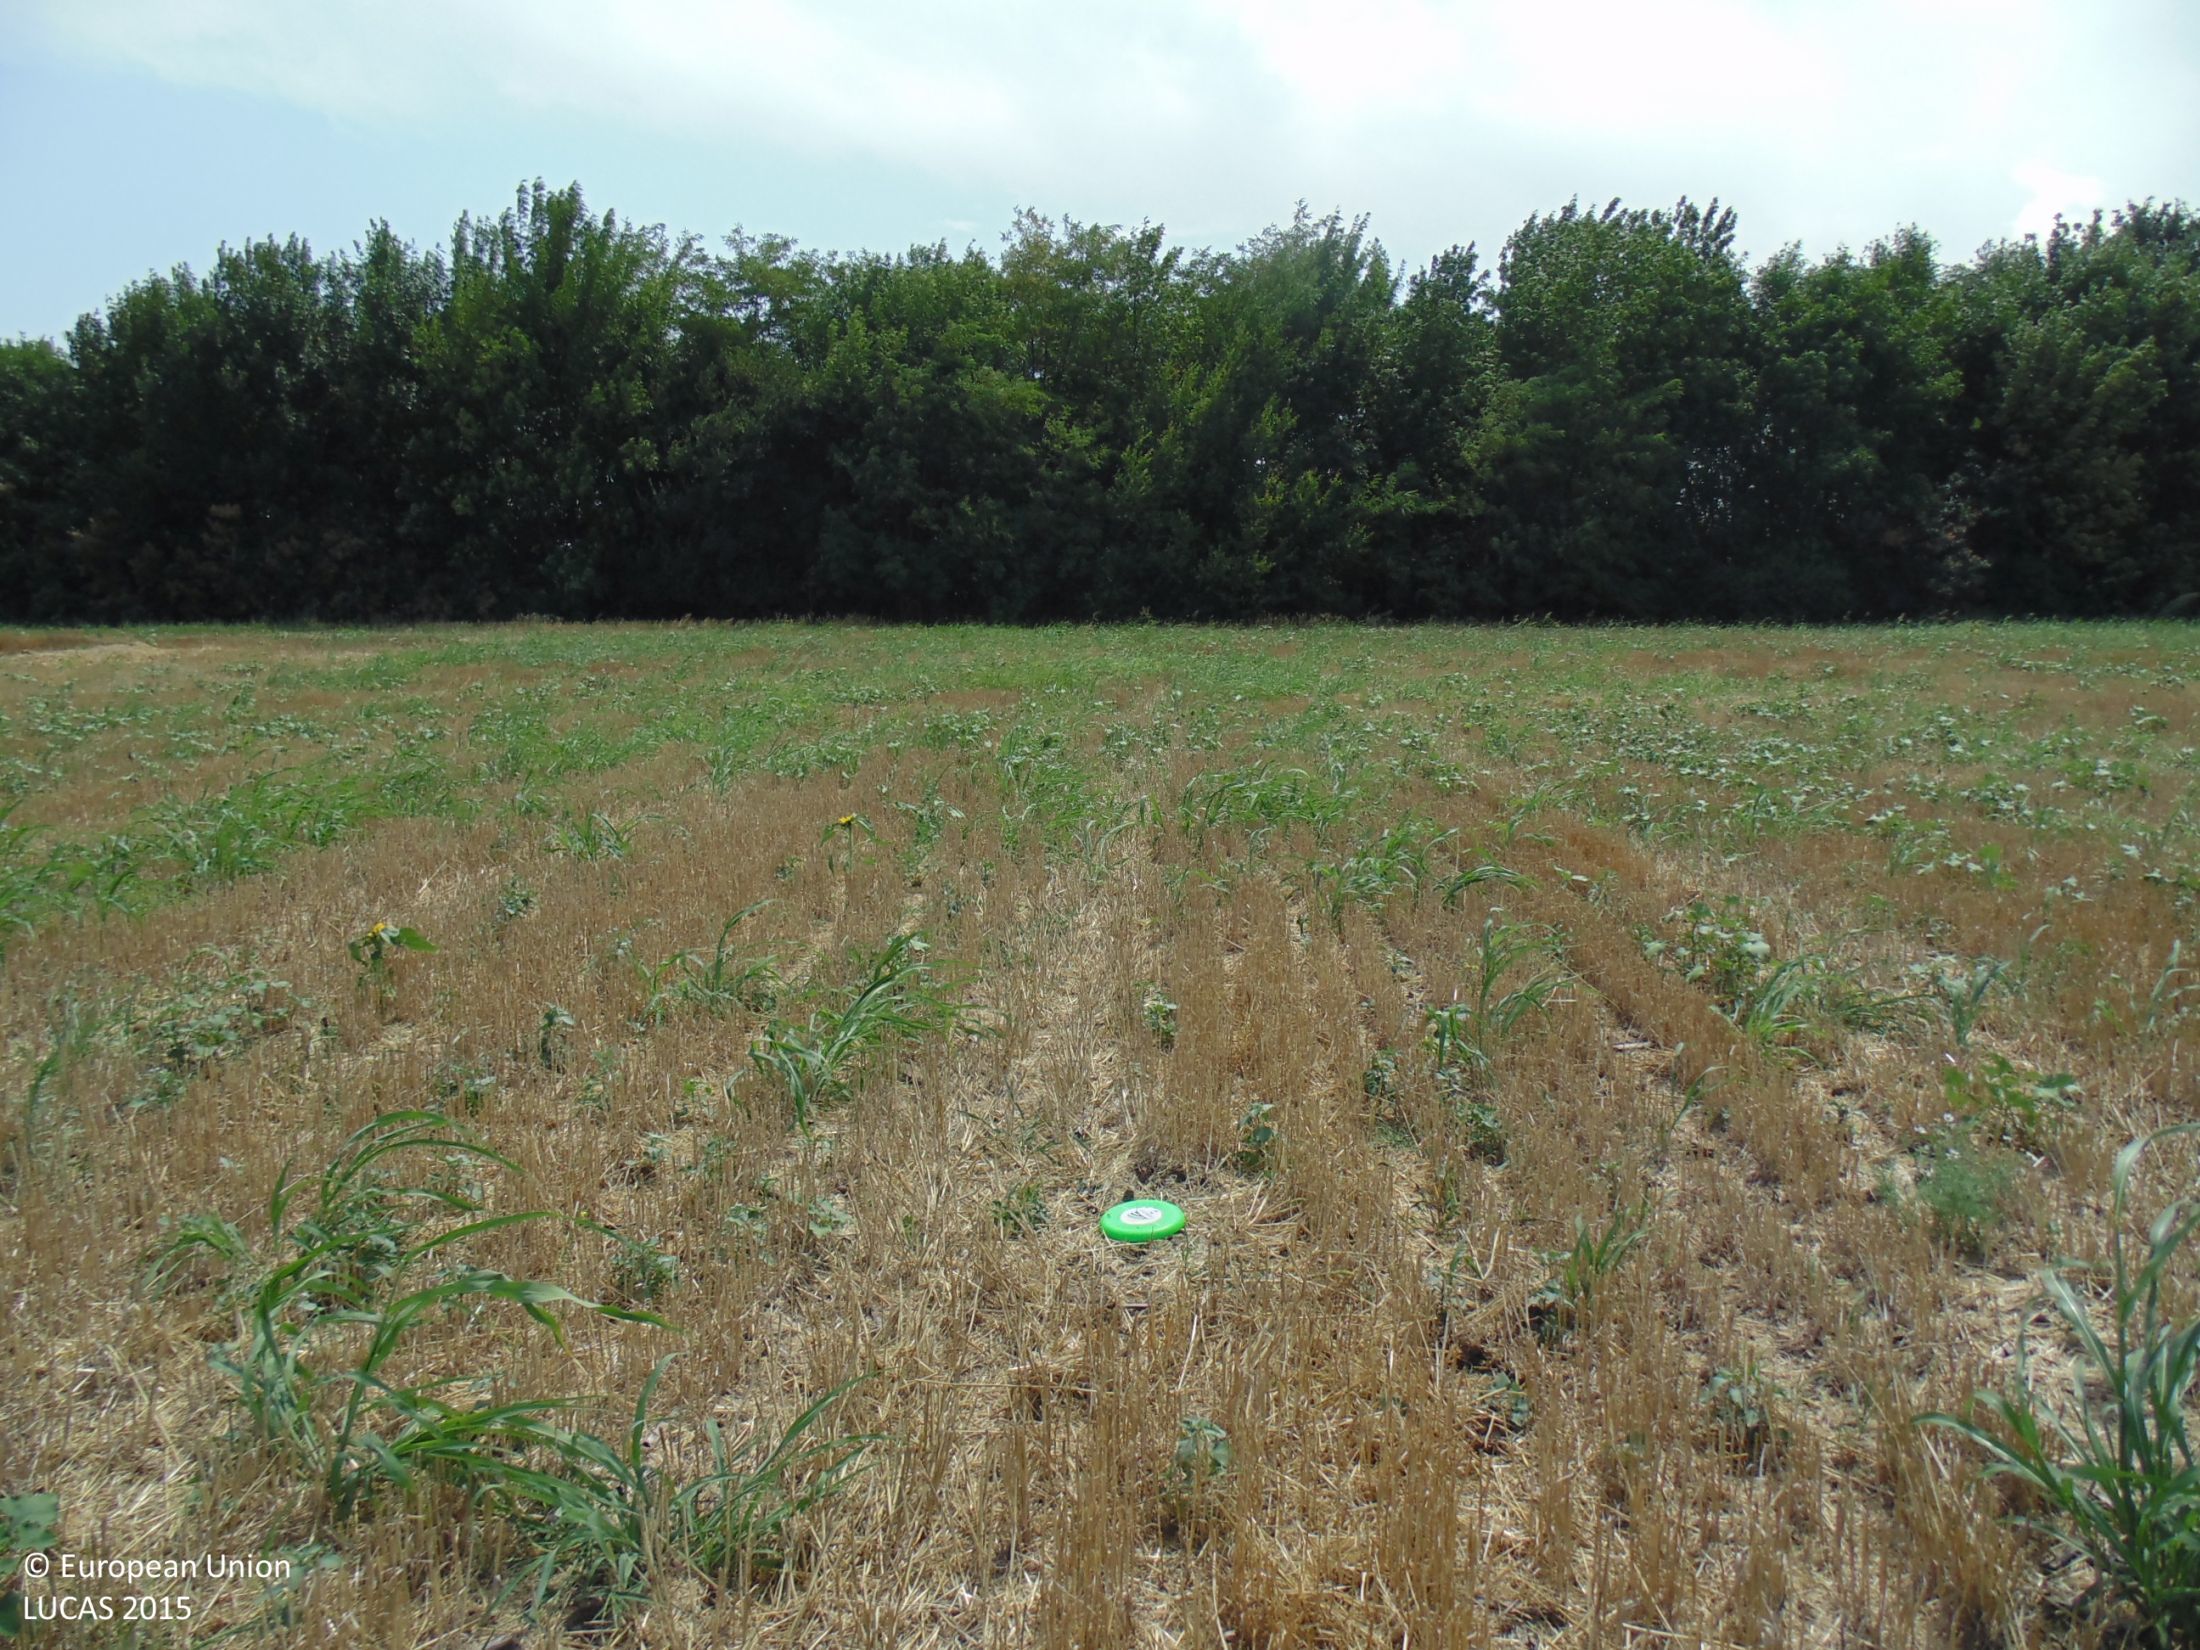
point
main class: Cropland
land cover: Common wheat
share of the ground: 25 - 50 %
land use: Agriculture (excluding fallow land and kitchen gardens)
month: August
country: BG
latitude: 43.7443
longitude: 28.1720
